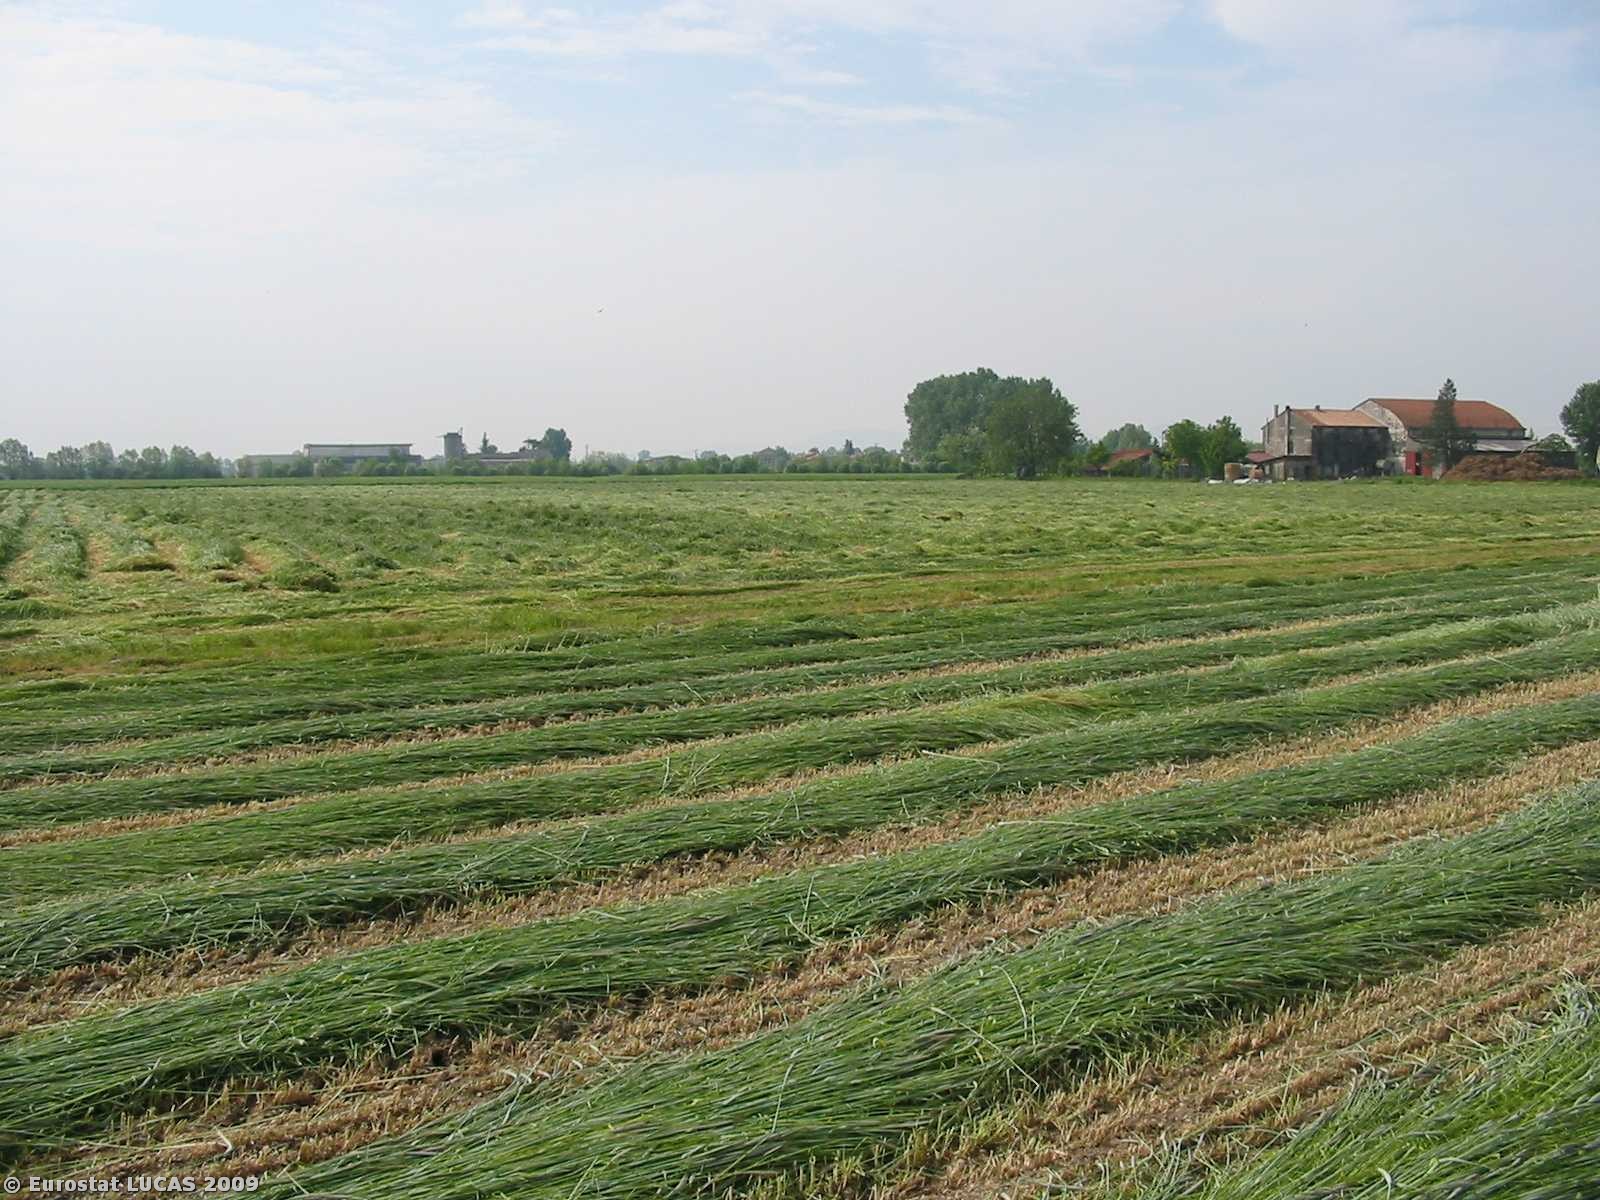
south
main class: Cropland
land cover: Rye
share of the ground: < 10 %
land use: Agriculture (excluding fallow land and kitchen gardens)
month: May
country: IT
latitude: 45.5083
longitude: 11.7251
